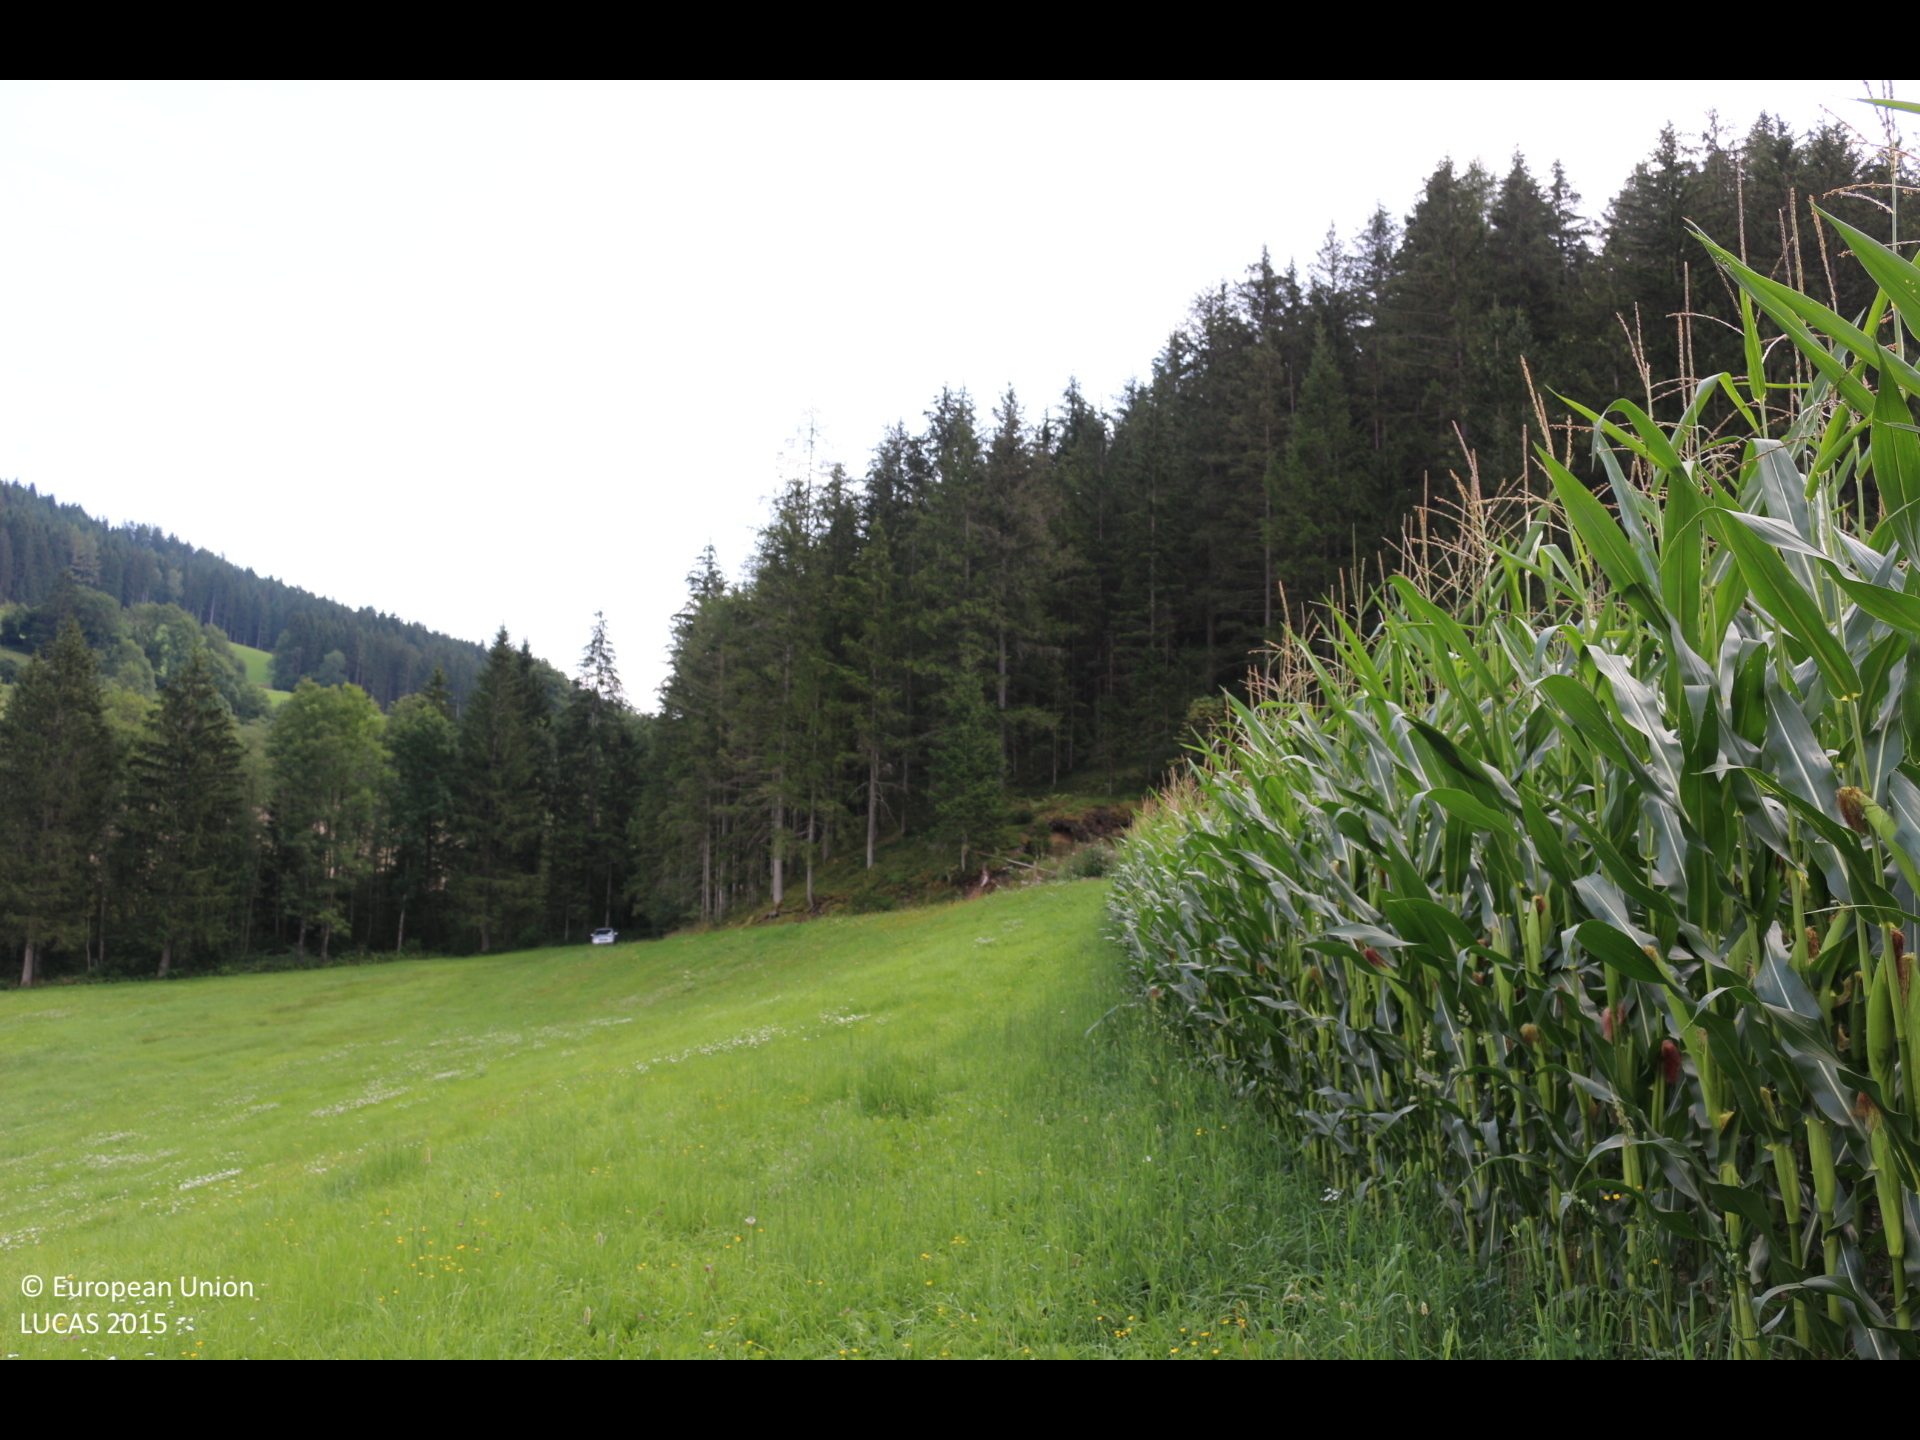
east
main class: Cropland
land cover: Maize
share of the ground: > 75 %
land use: Agriculture (excluding fallow land and kitchen gardens)
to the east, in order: Maize; Tracks; Spruce dominated coniferous woodland; Spruce dominated mixed woodland; Spruce dominated coniferous woodland; Tracks; Fences; Grassland without tree/shrub cover
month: August
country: AT
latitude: 46.8665
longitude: 14.1301
